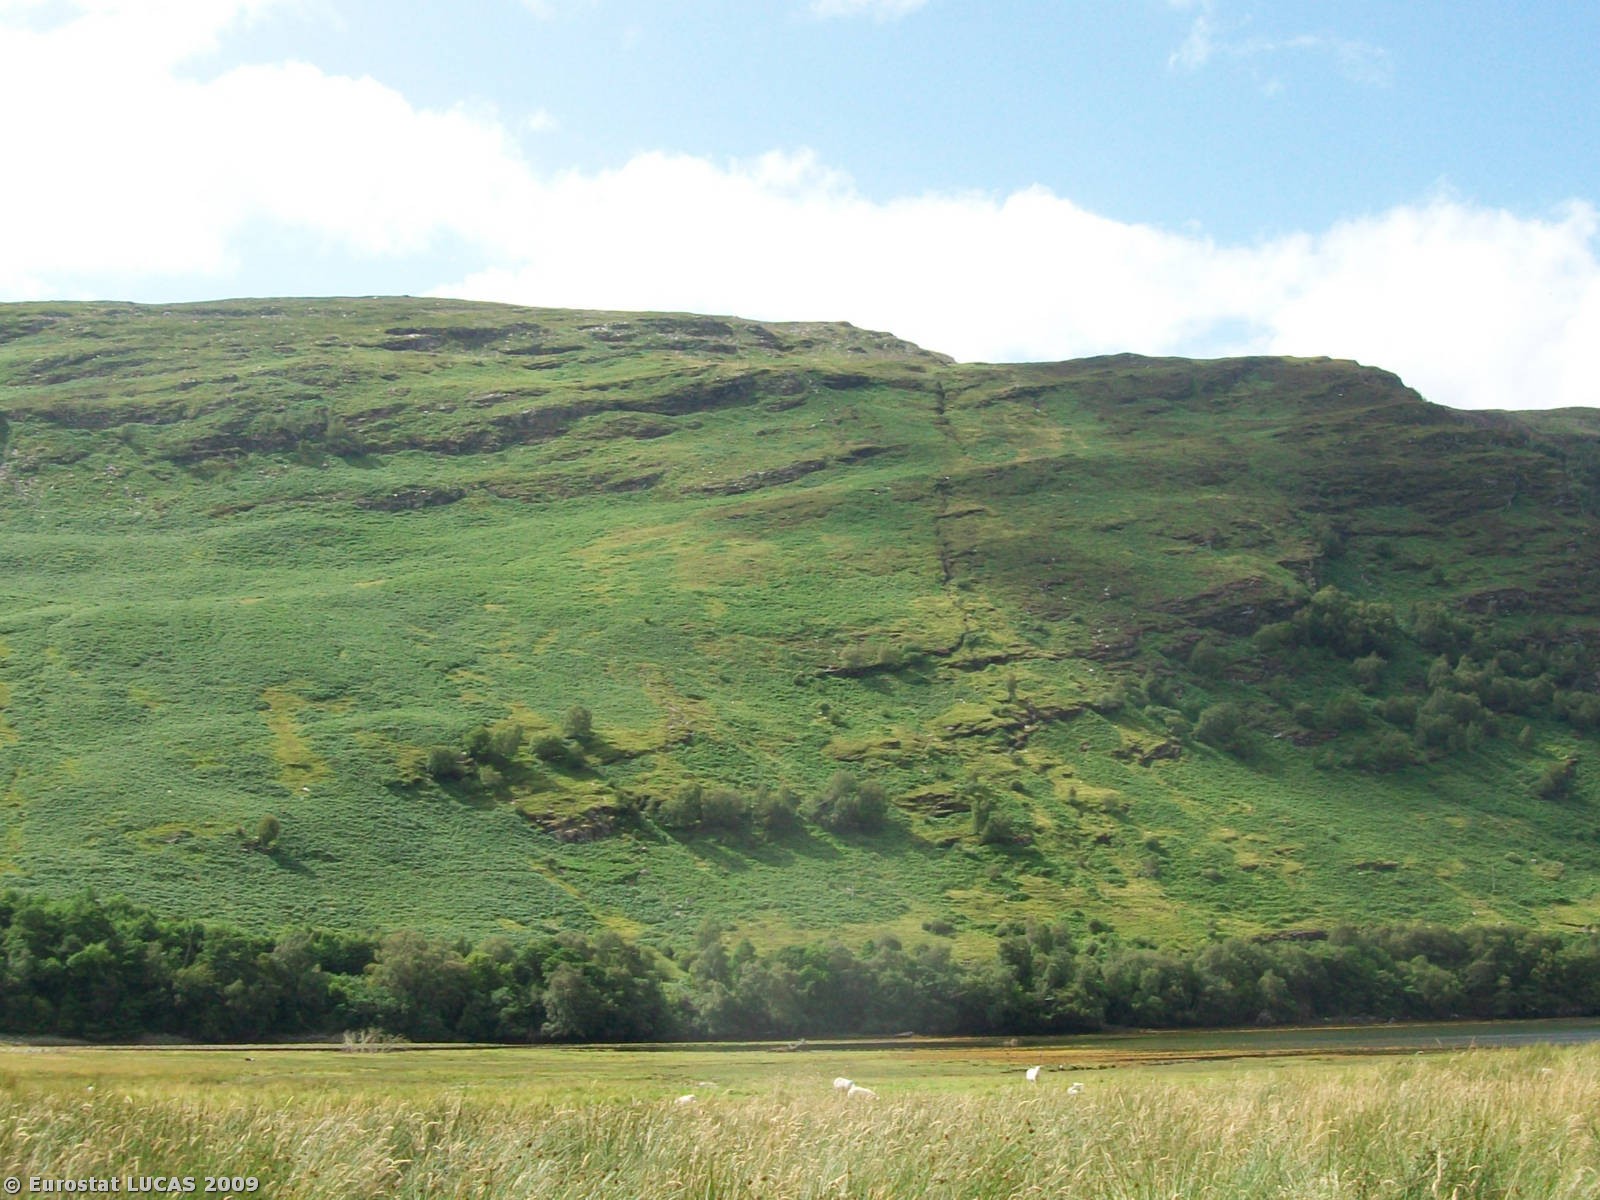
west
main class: Grassland
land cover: Grassland without tree/shrub cover
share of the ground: > 75 %
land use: Agriculture (excluding fallow land and kitchen gardens)
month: July
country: GB
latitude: 57.8214
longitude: -5.0692
